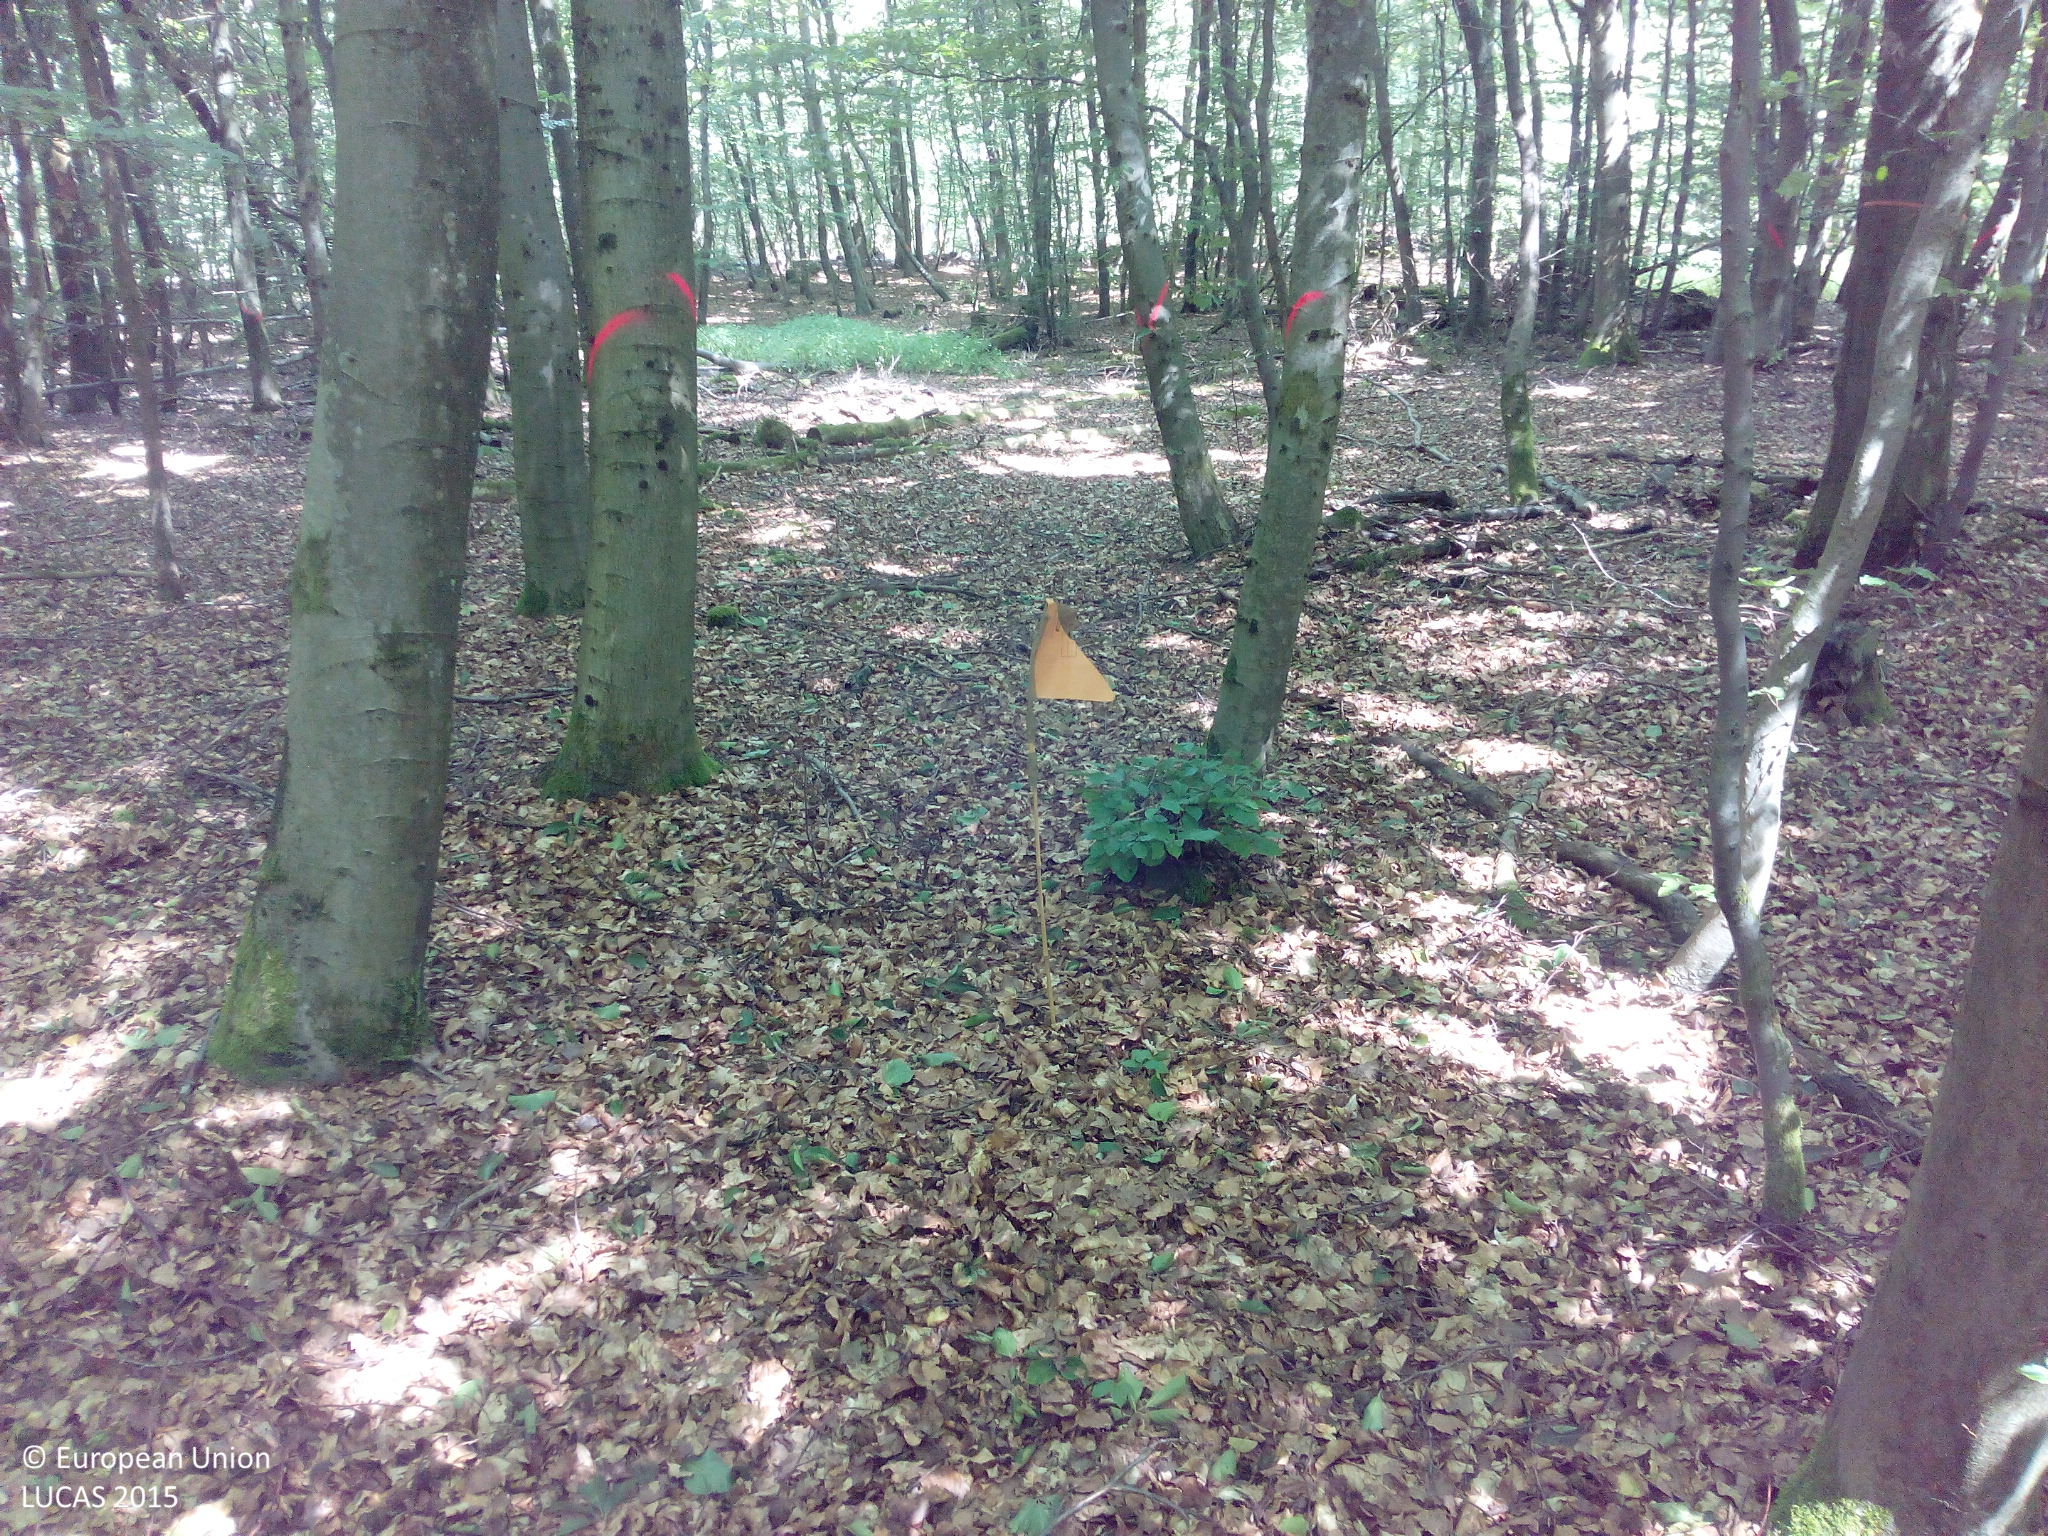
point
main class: Woodland
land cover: Broadleaved woodland
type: mesophytic deciduous forest
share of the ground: > 75 %
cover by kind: broadleaved forest trees 100 %
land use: Forestry
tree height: > 5 m
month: July
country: DE
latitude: 49.6637
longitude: 7.1878
